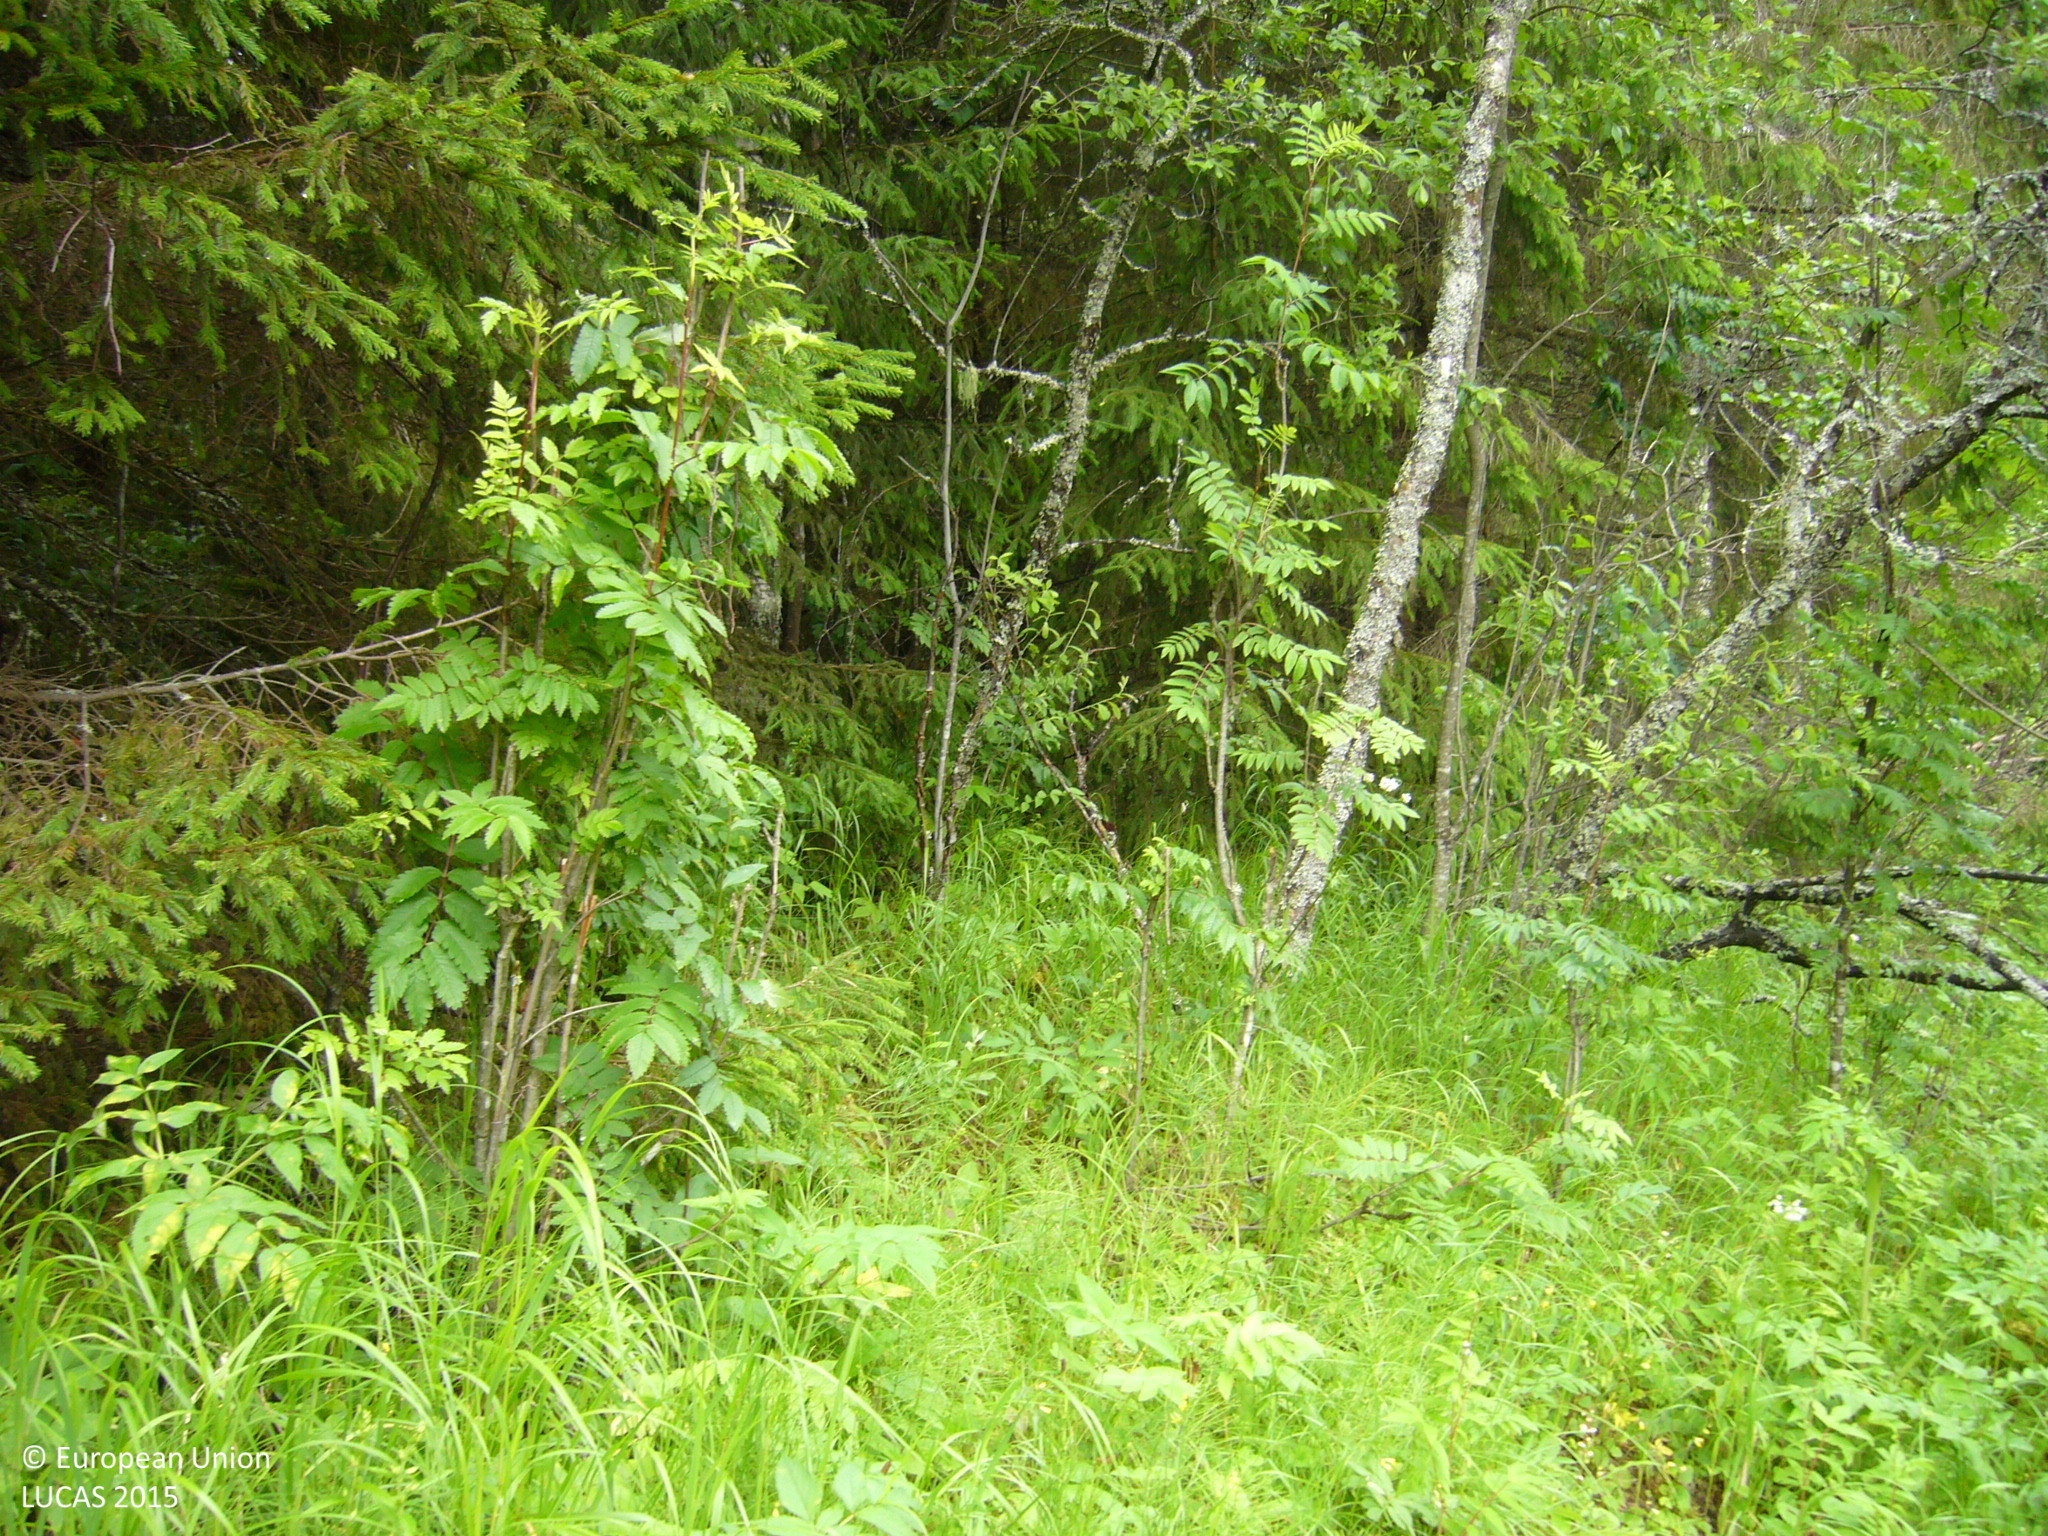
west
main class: Woodland
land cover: Spruce dominated mixed woodland
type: boreal forest
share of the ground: > 75 %
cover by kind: coniferous forest trees 60 %, broadleaved forest trees 30 %, shrubs 10 %
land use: Forestry
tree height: > 5 m
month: July
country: FI
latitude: 63.5011
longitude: 25.6742
